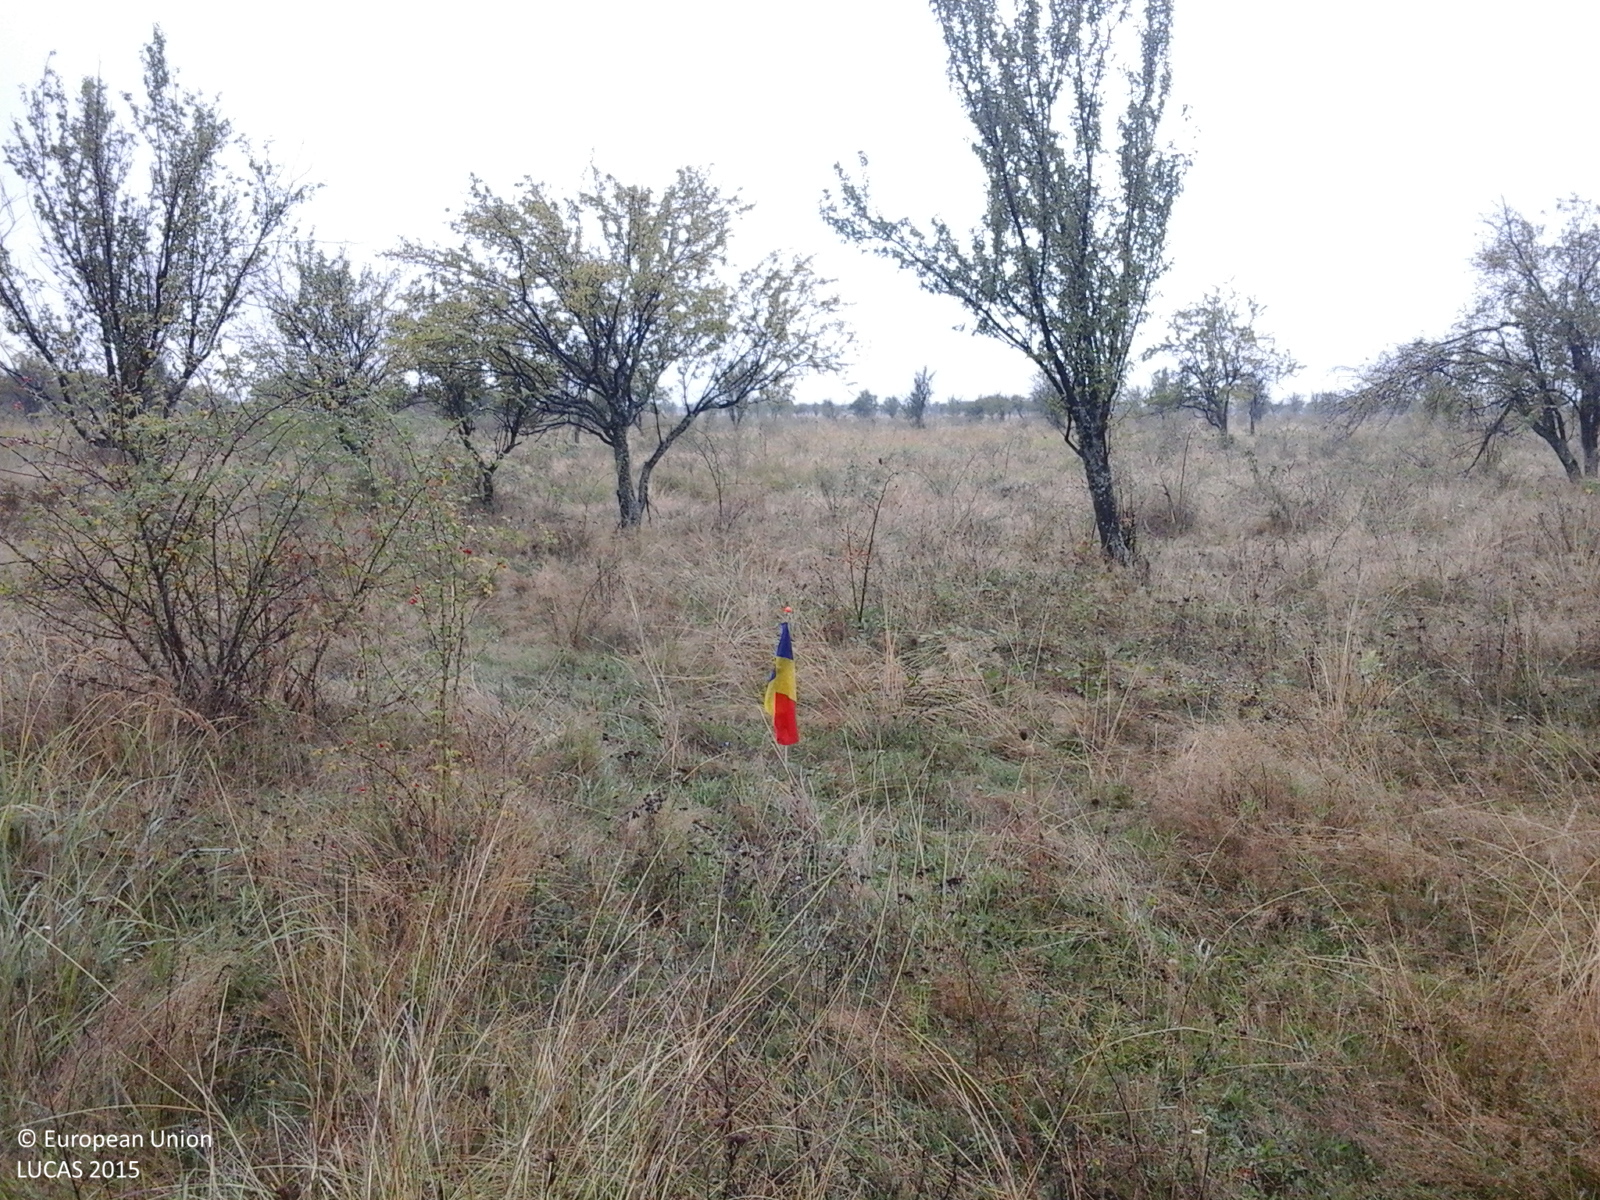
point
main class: Cropland
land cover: Apple fruit
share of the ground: 50 - 75 %
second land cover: Grassland without tree/shrub cover
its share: > 75 %
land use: Agriculture (excluding fallow land and kitchen gardens)
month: September
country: RO
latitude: 45.0809
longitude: 23.5631
